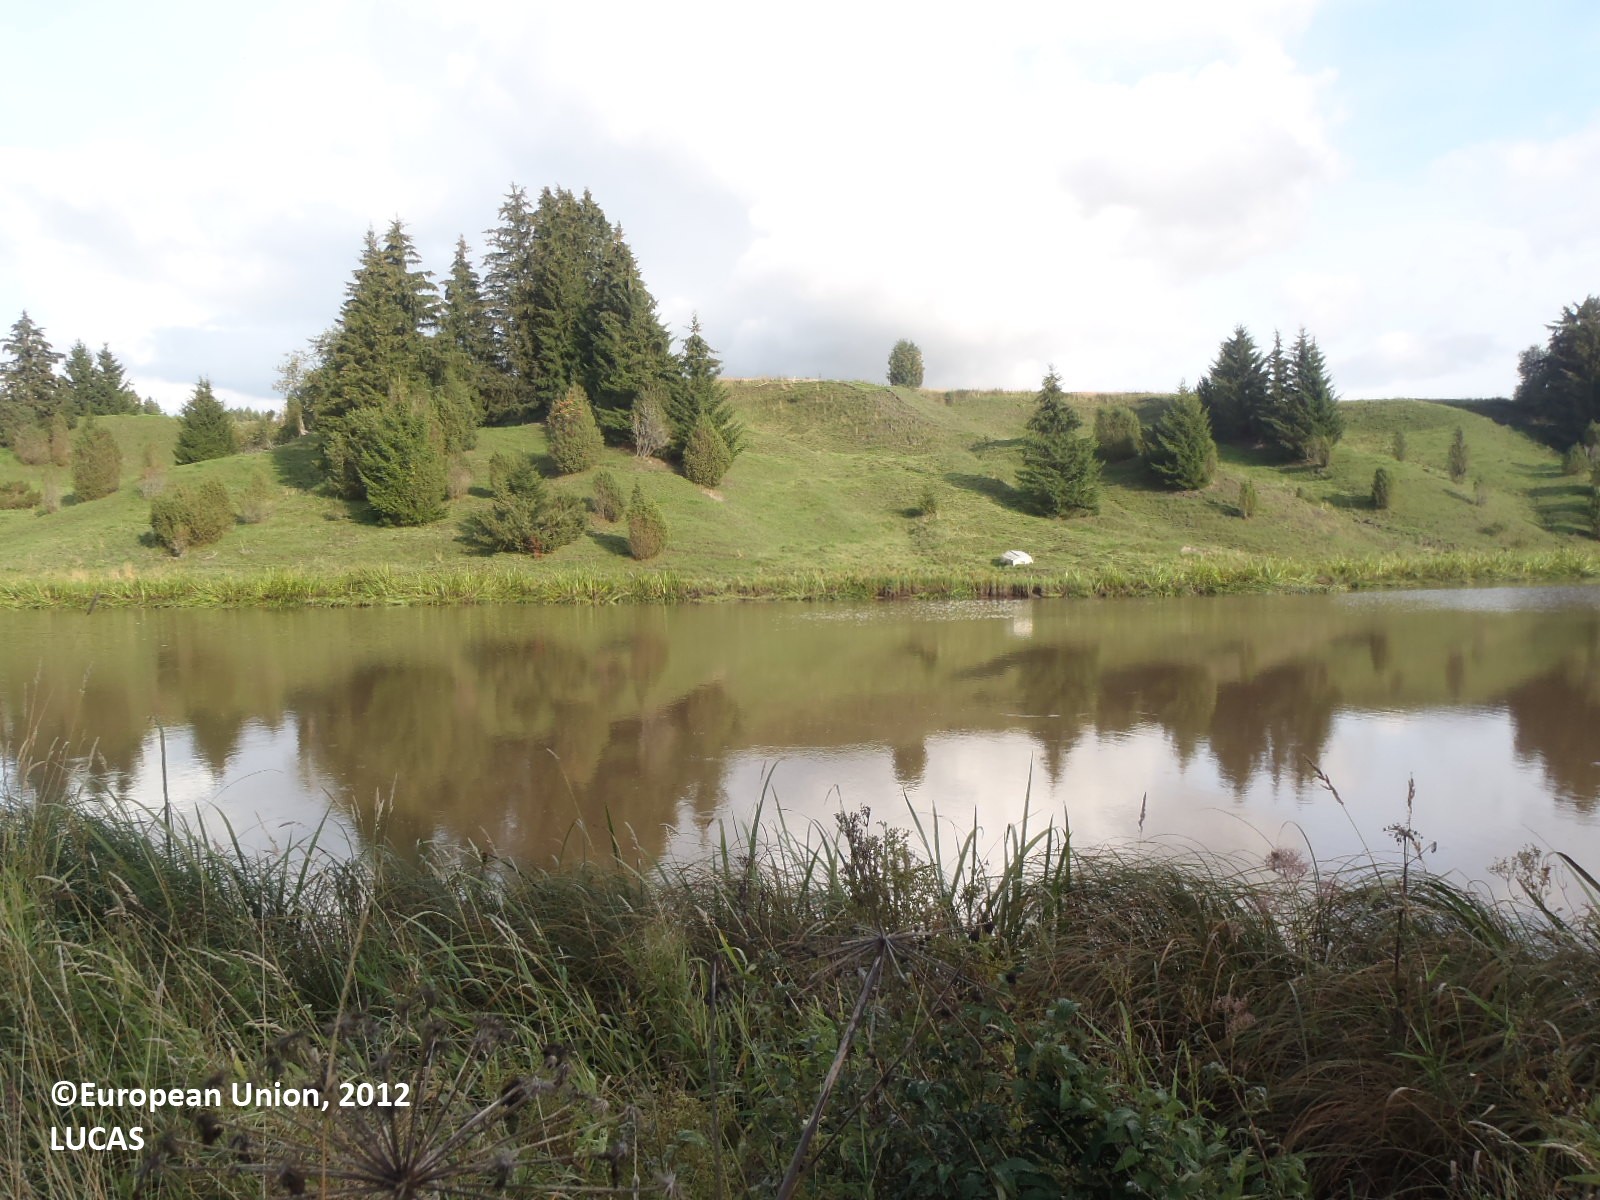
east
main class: Grassland
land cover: Grassland without tree/shrub cover
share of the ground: > 75 %
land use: Agriculture (excluding fallow land and kitchen gardens)
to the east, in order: Grassland without tree/shrub cover; Inland running water; Grassland without tree/shrub cover; Spruce dominated coniferous woodland; Grassland with sparse tree/shrub cover; Arable land (only in case pi)
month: August
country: FI
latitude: 60.5352
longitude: 22.7032
